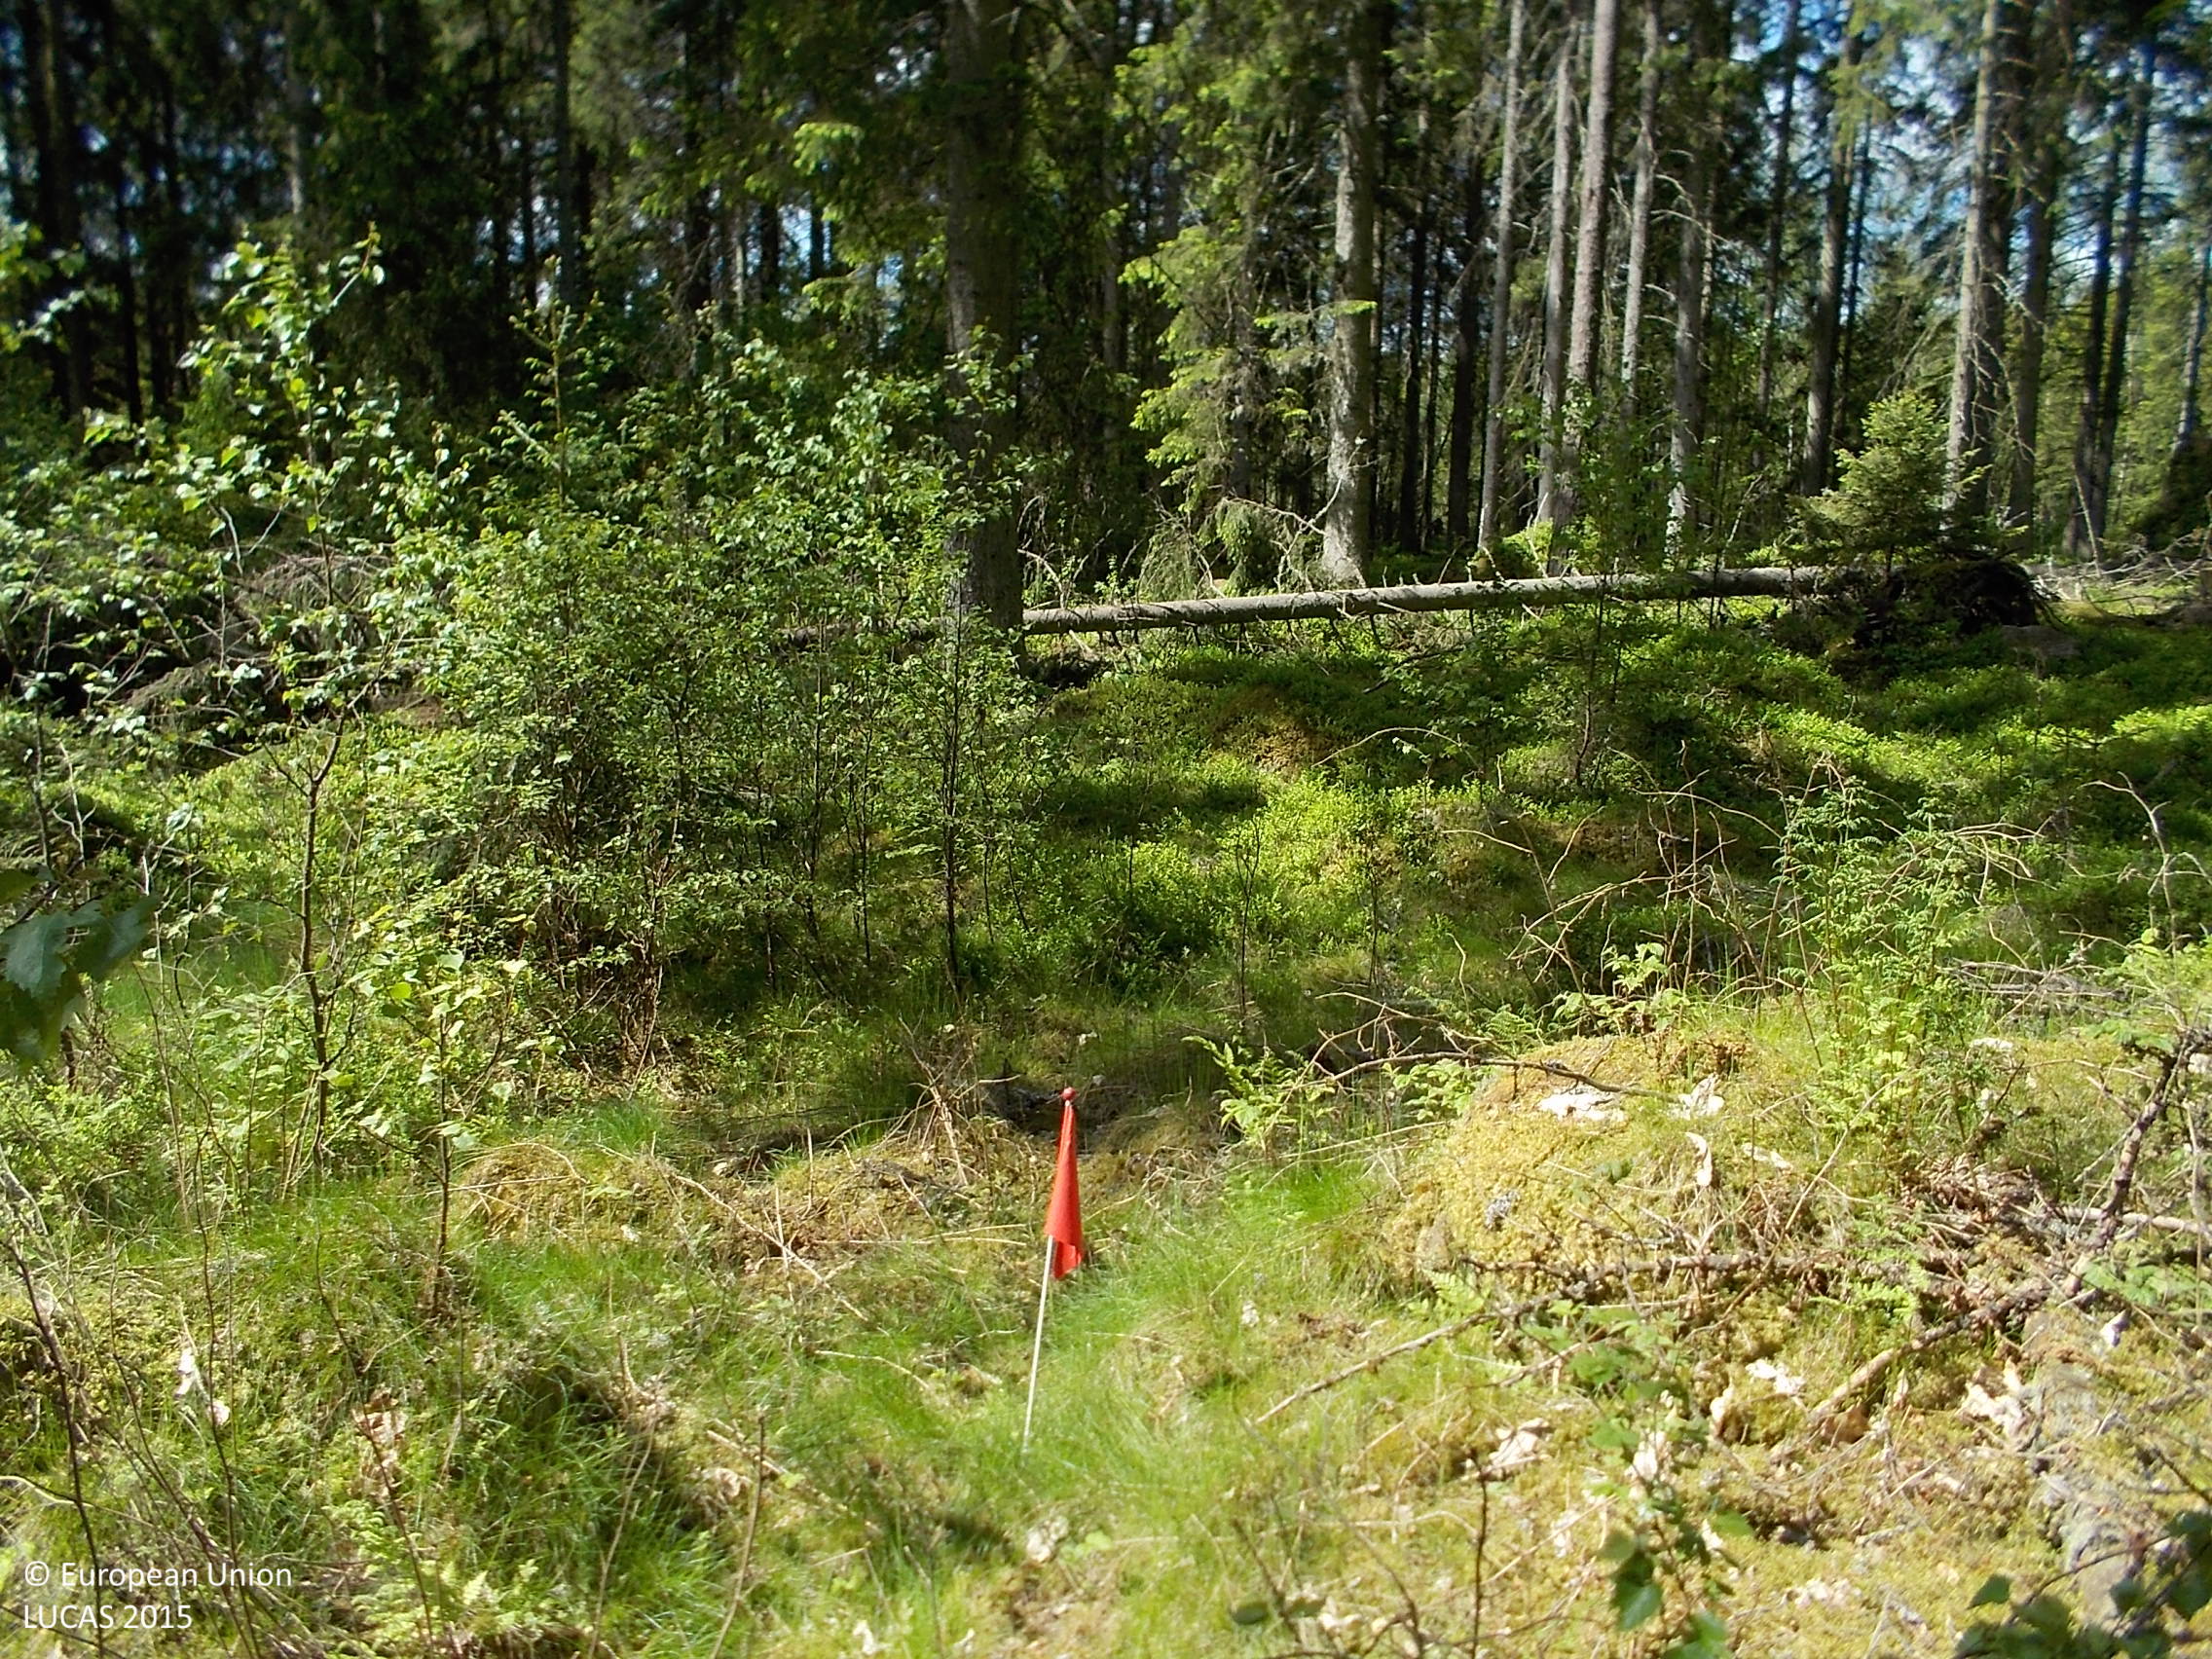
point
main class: Woodland
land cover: Spruce dominated coniferous woodland
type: boreal forest
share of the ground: 50 - 75 %
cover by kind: coniferous forest trees 70 %, shrubs 10 %, lichens and mosses 10 %, broadleaved forest trees 5 %, herbaceous plants 5 %
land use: Forestry
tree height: > 5 m
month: June
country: SE
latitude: 57.6759
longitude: 13.2652
